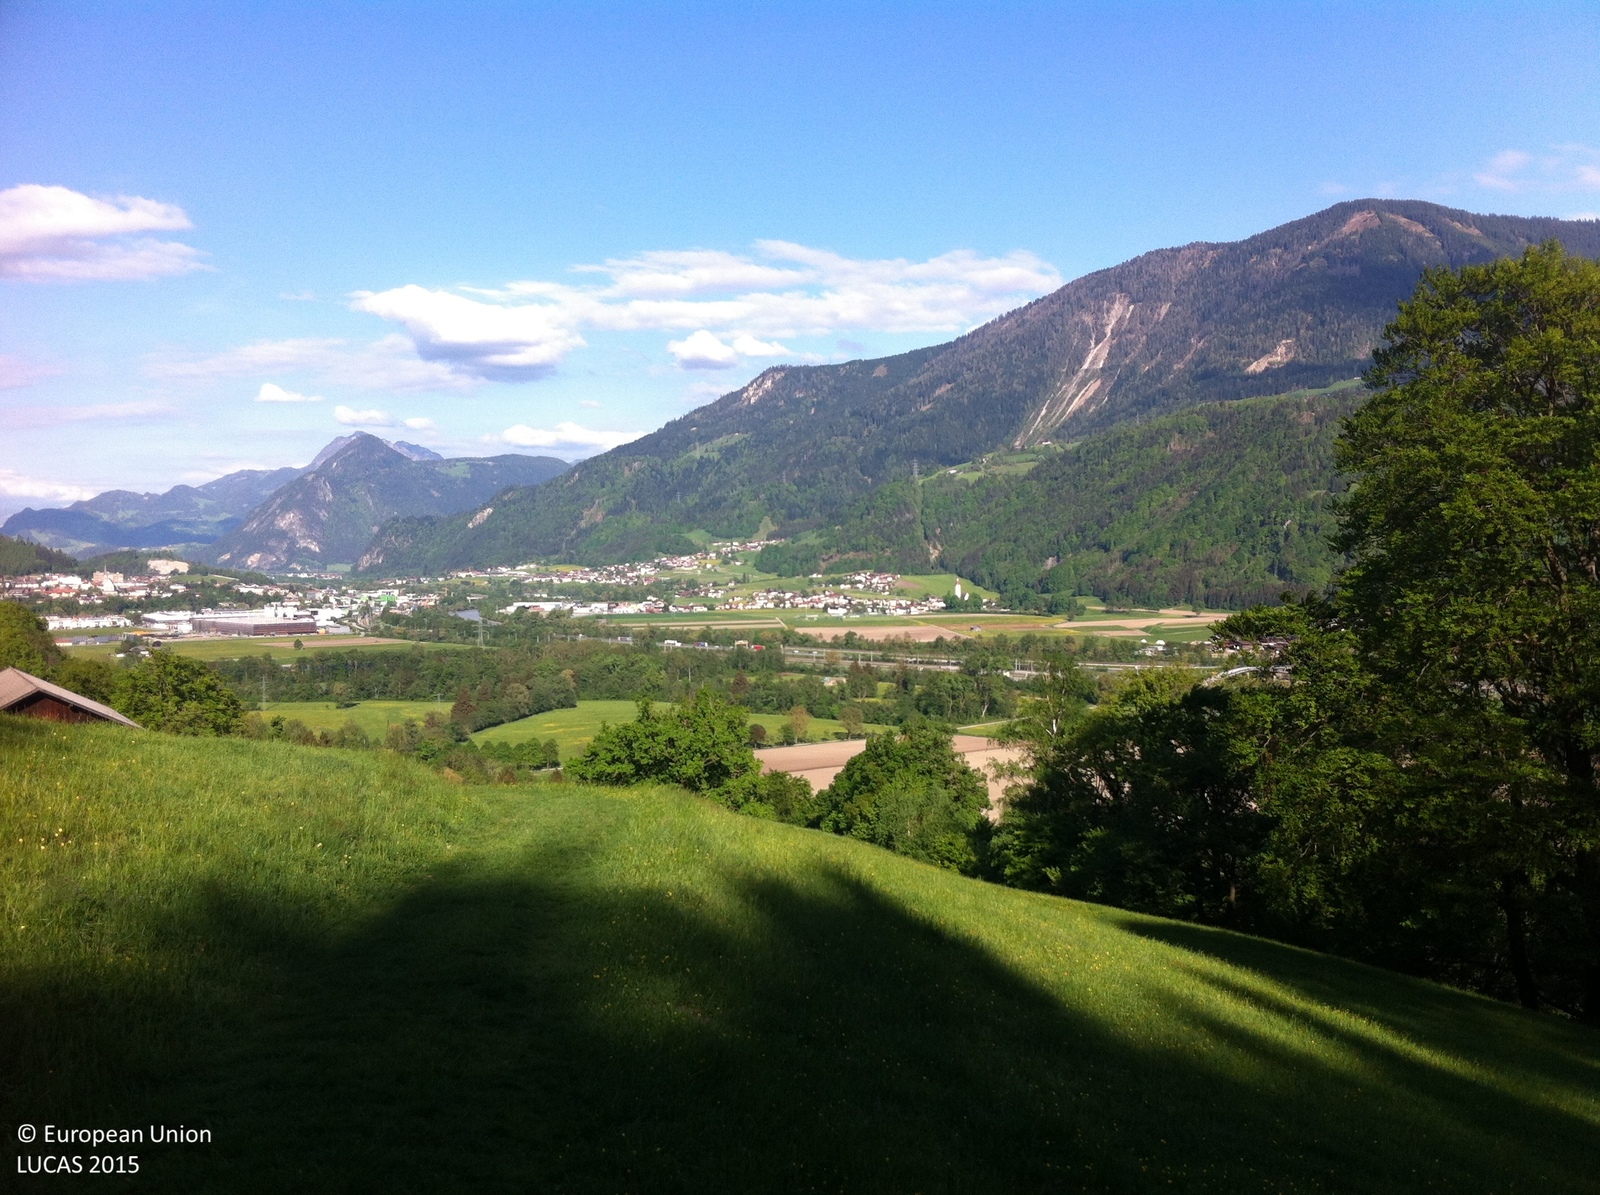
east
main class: Grassland
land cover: Grassland without tree/shrub cover
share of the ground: > 75 %
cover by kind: herbaceous plants 100 %
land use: Agriculture (excluding fallow land and kitchen gardens)
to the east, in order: Grassland without tree/shrub cover; Artificial constructions in urban areas; Grassland with sparse tree/shrub cover; Pear fruit; Grassland without tree/shrub cover; Electric lines; Grassland without tree/shrub cover; Broadleaved woodland; Paved roads, cycling and walking lanes; Shruby margins; Broadleaved woodland
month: May
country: AT
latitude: 47.3818
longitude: 11.7337
